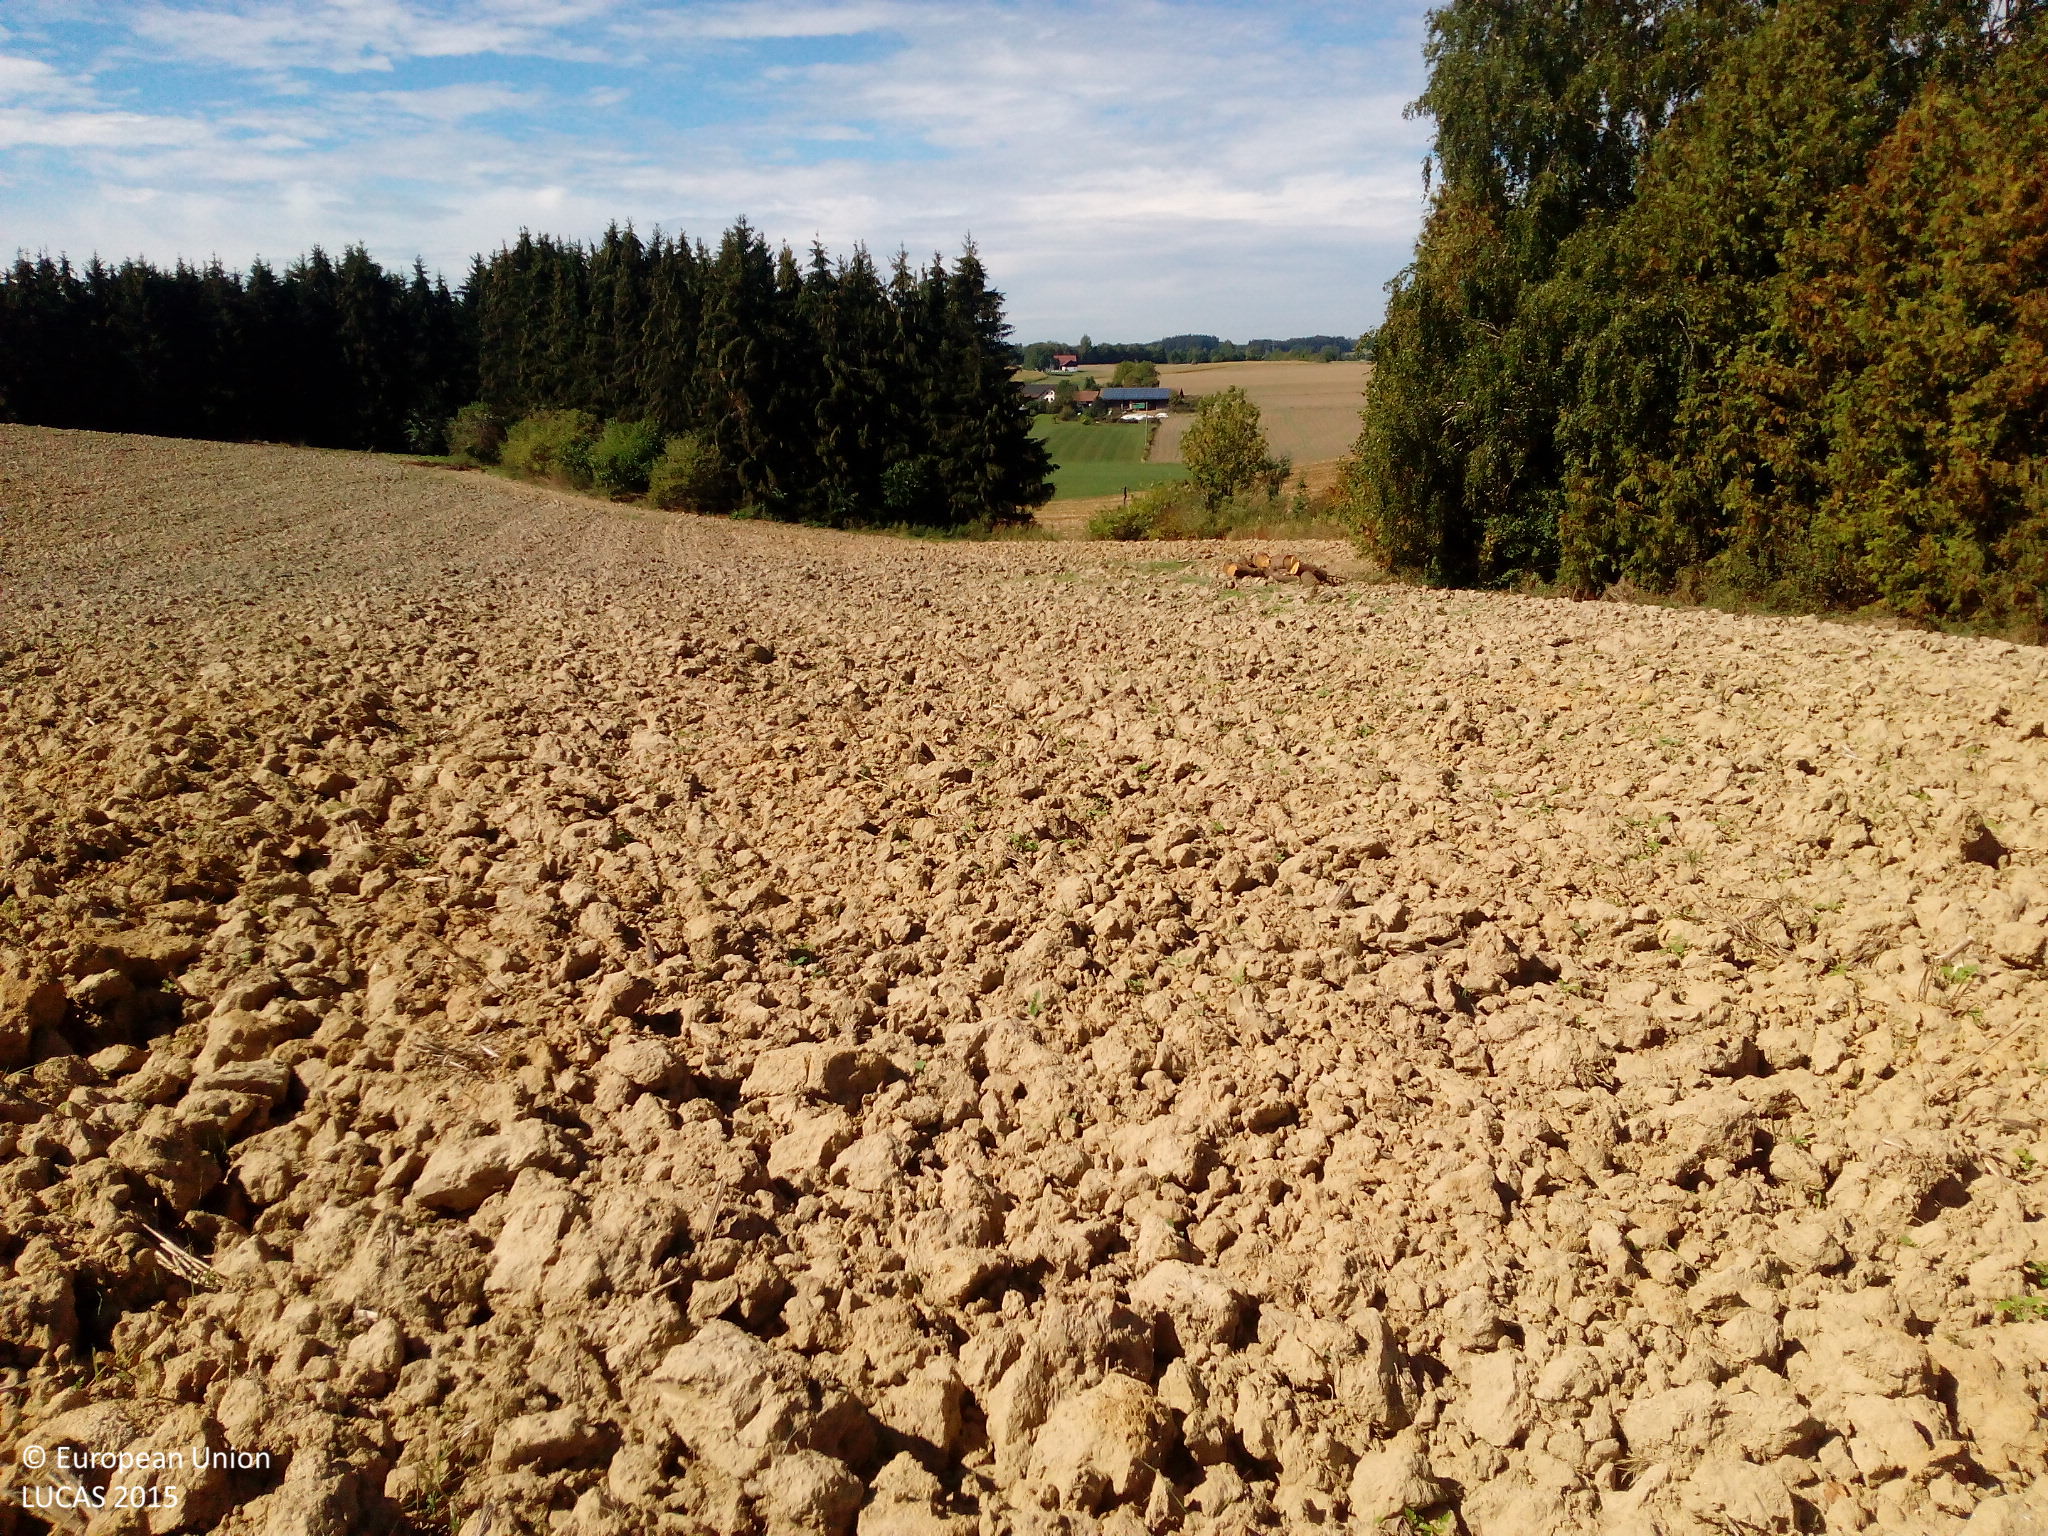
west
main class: Cropland
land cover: Rape and turnip rape
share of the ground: < 10 %
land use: Agriculture (excluding fallow land and kitchen gardens)
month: September
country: DE
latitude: 48.4202
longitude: 12.0665
